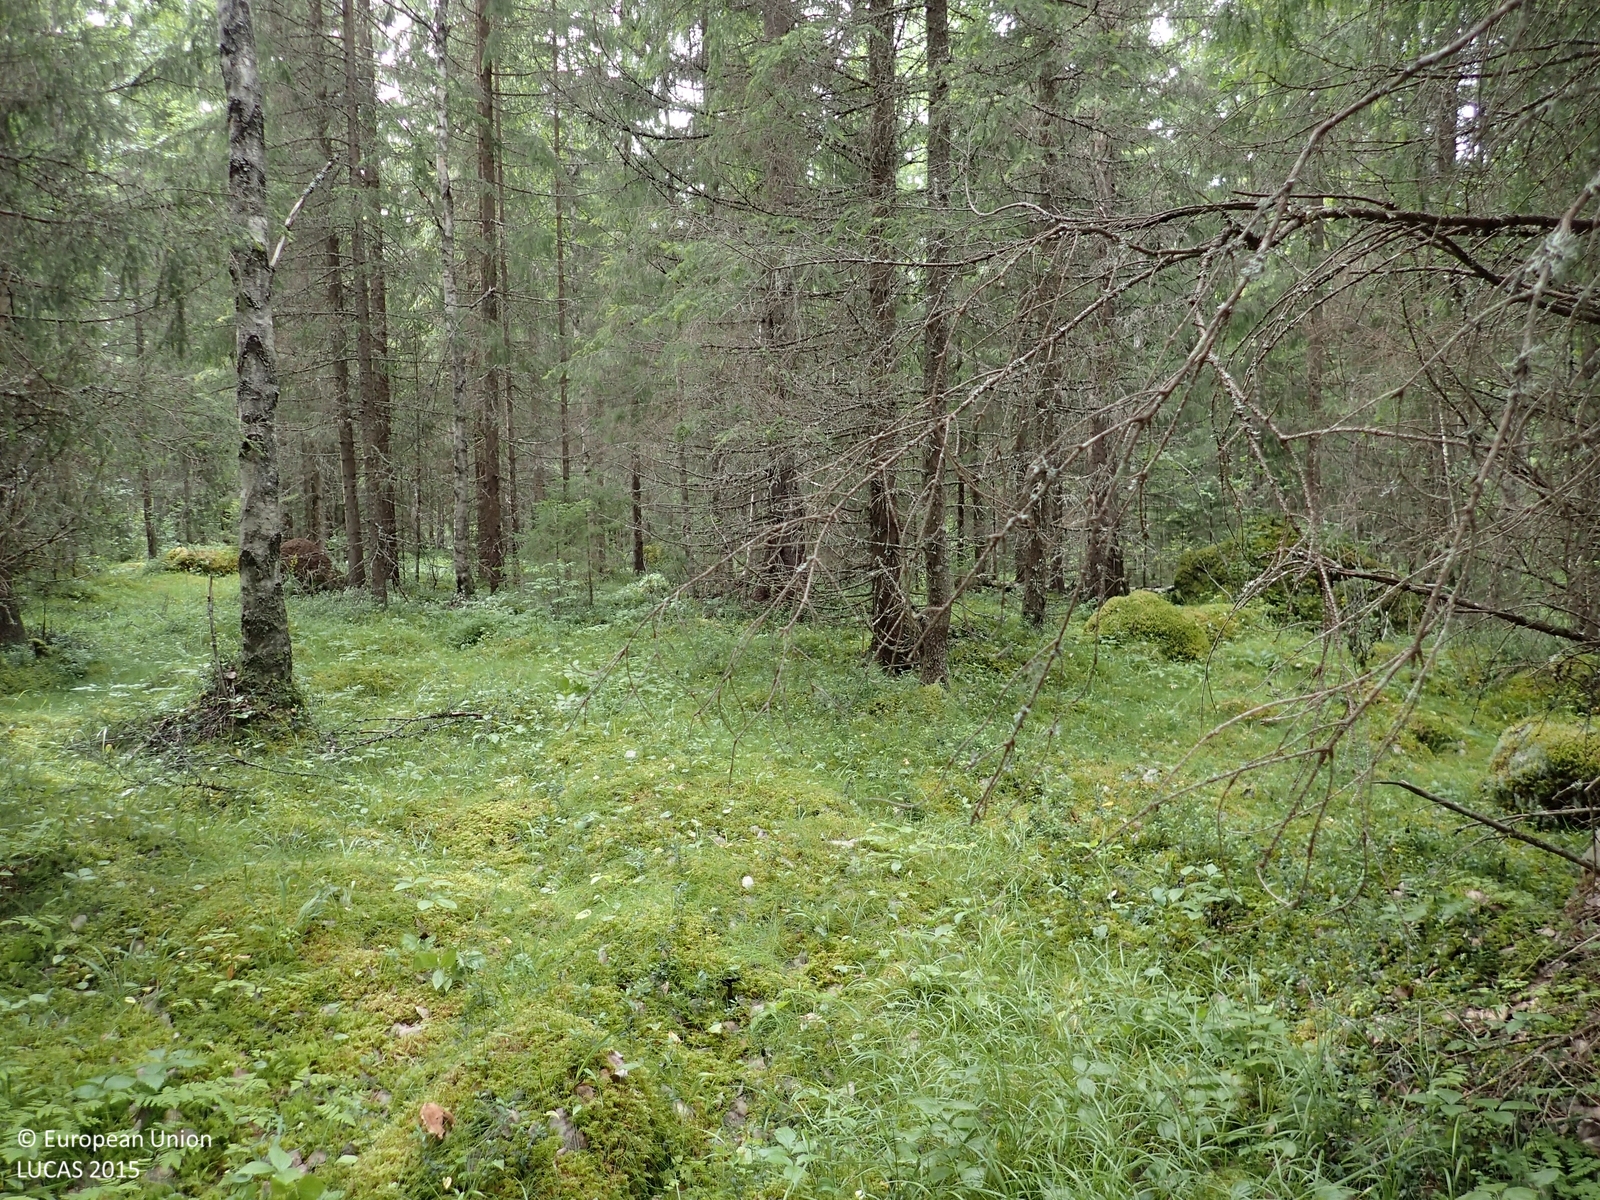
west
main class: Woodland
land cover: Spruce dominated mixed woodland
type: boreal forest
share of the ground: > 75 %
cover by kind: coniferous forest trees 60 %, broadleaved forest trees 20 %, herbaceous plants 10 %, shrubs 5 %, lichens and mosses 5 %
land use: Forestry
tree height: > 5 m
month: August
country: FI
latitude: 62.8314
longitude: 21.9221
